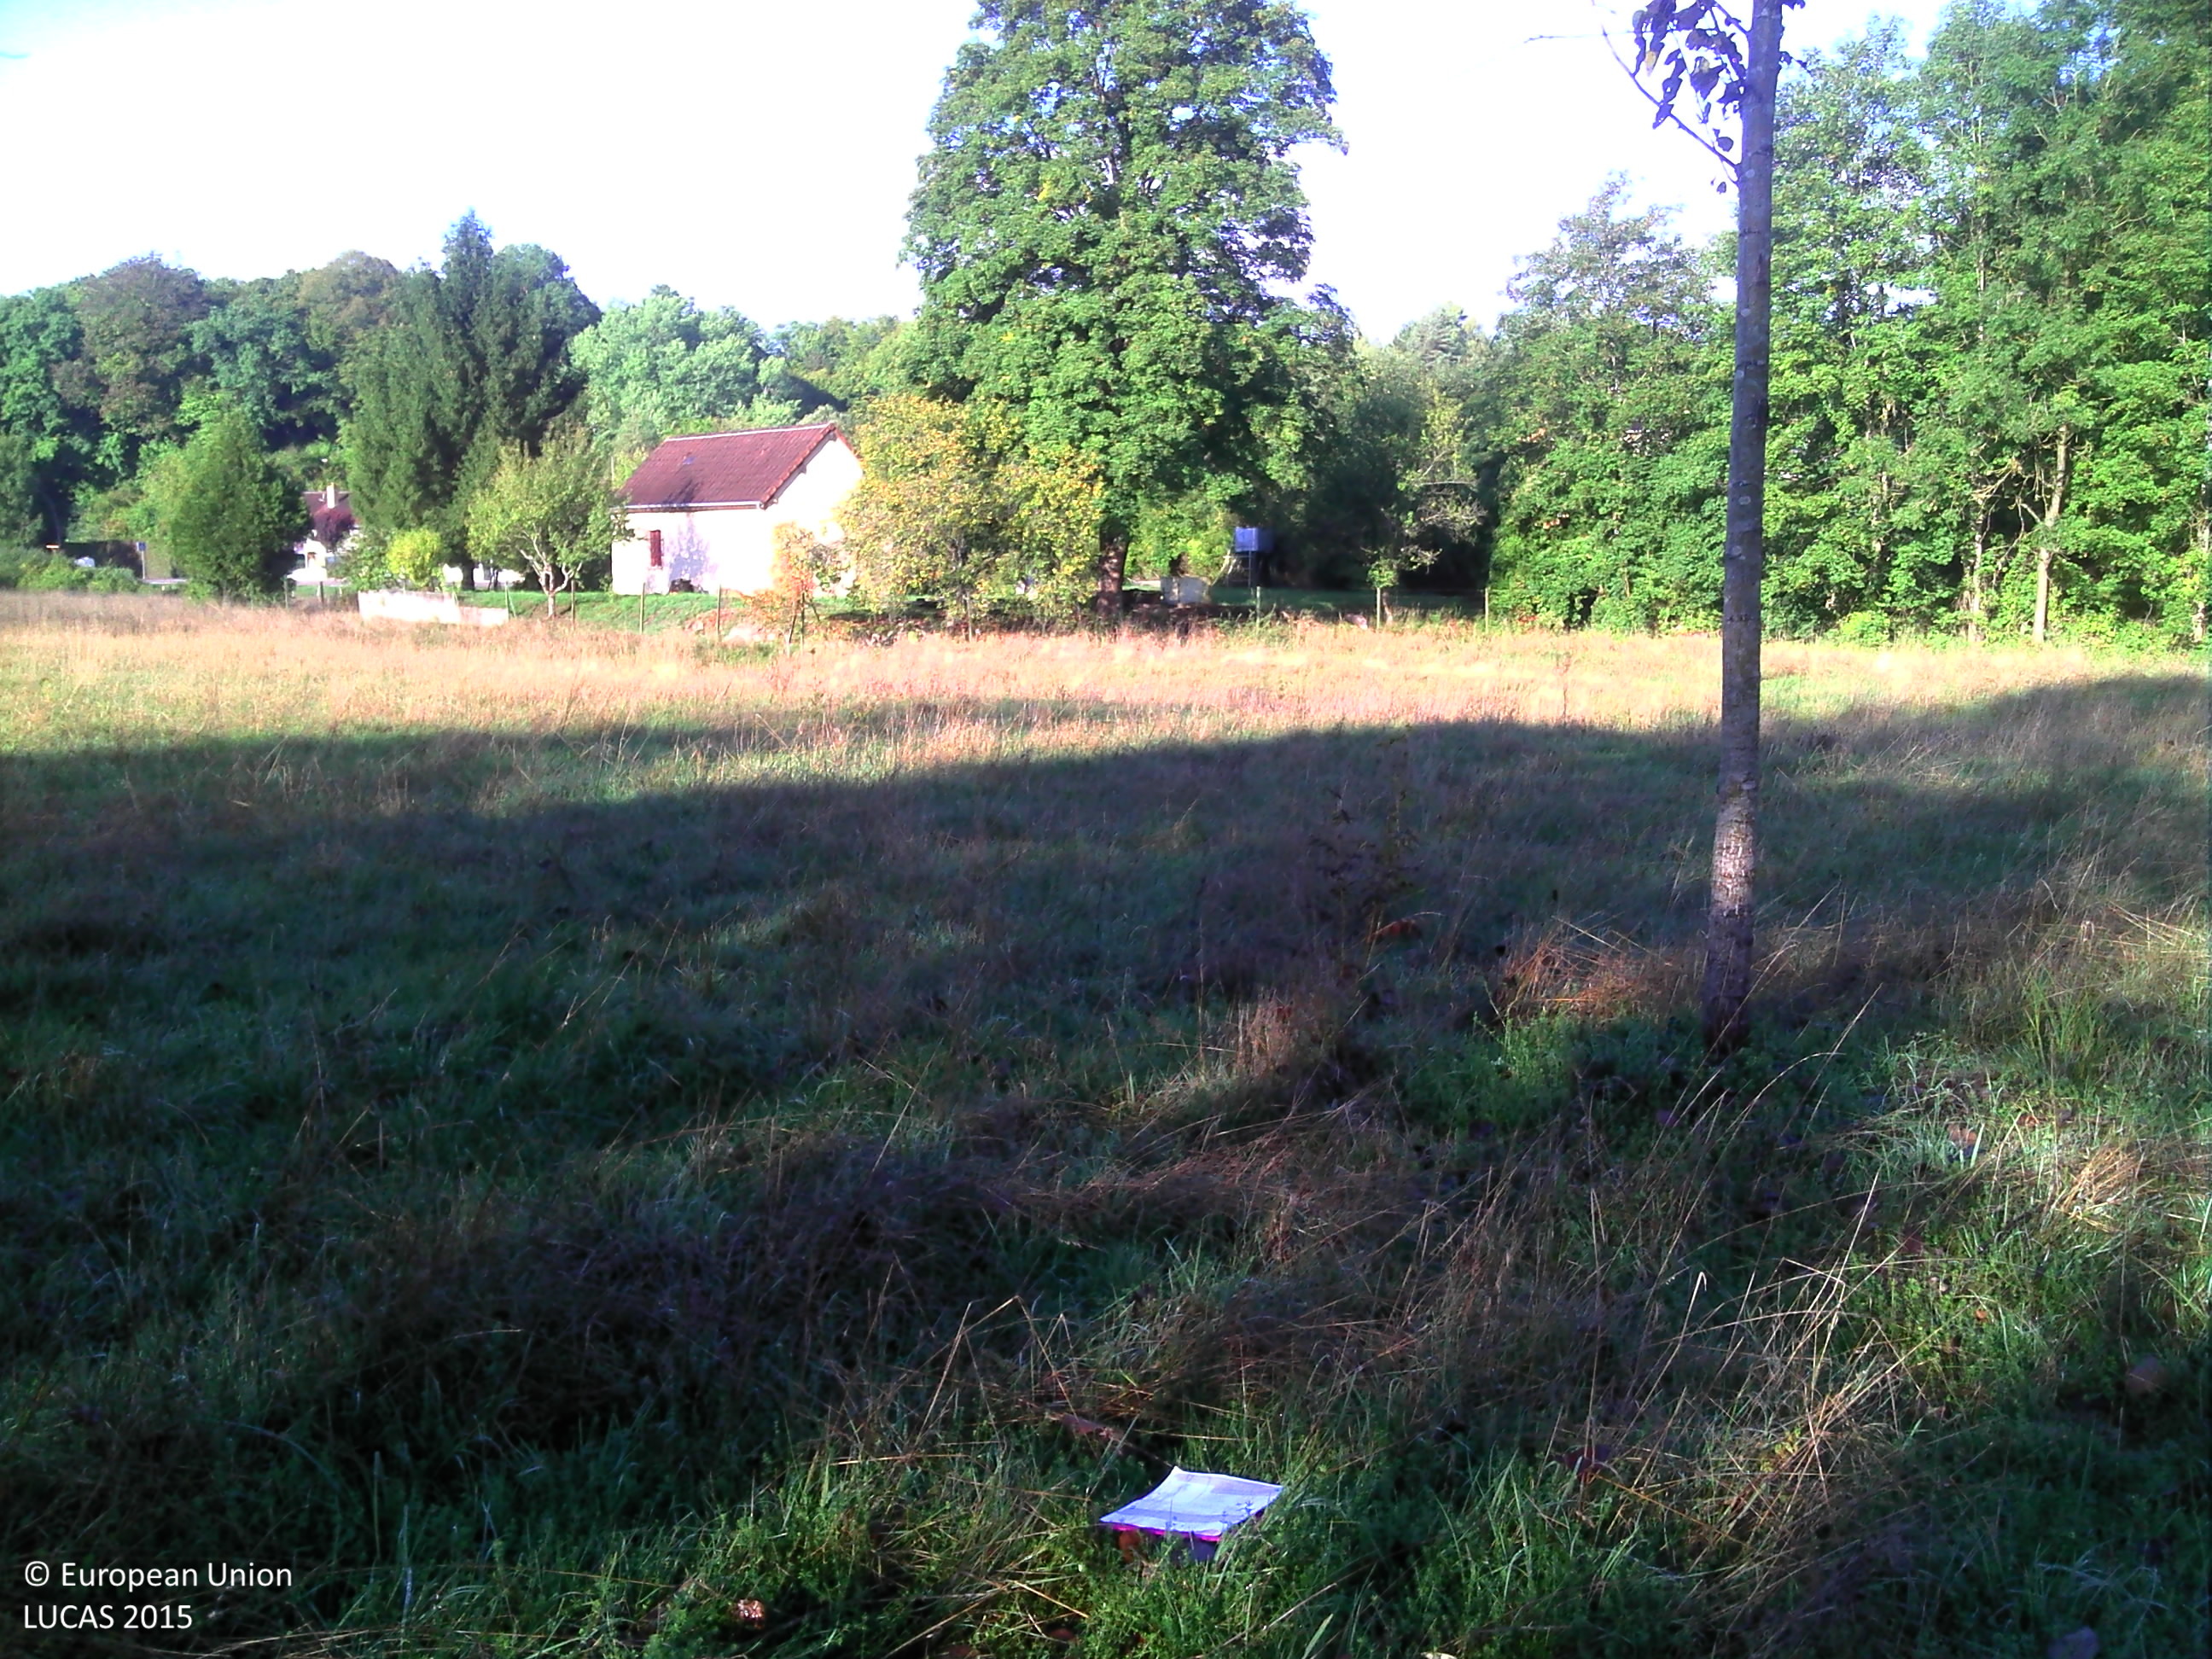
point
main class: Woodland
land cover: Broadleaved woodland
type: exotic forest
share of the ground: 25 - 50 %
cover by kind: herbaceous plants 65 %, broadleaved forest trees 35 %
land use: Forestry
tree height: > 5 m
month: September
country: FR
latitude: 48.1548
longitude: 4.7961
